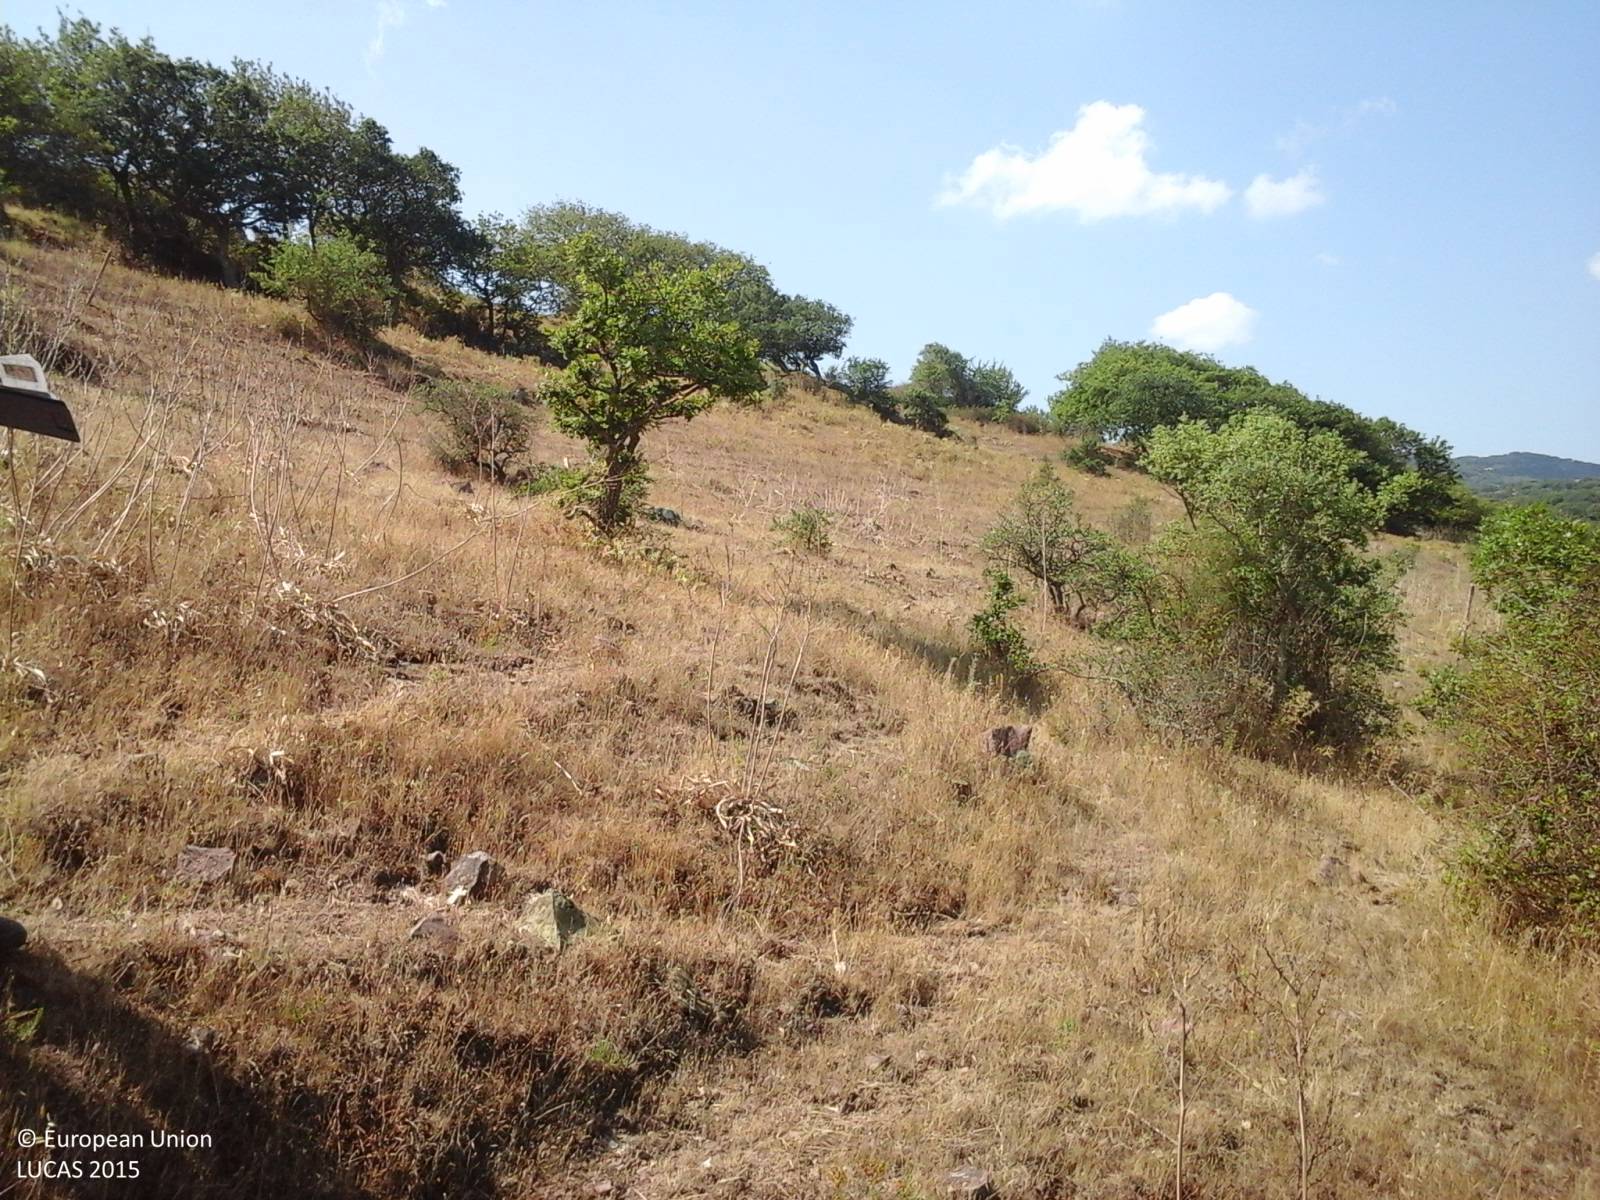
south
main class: Woodland
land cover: Broadleaved woodland
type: broadleaved evergreen forest
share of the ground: 10 - 25 %
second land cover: Grassland without tree/shrub cover
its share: 25 - 50 %
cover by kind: herbaceous plants 65 %, broadleaved forest trees 25 %, shrubs 10 %
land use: Forestry
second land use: Agriculture (excluding fallow land and kitchen gardens)
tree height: > 5 m
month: July
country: IT
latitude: 40.5272
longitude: 8.4848
